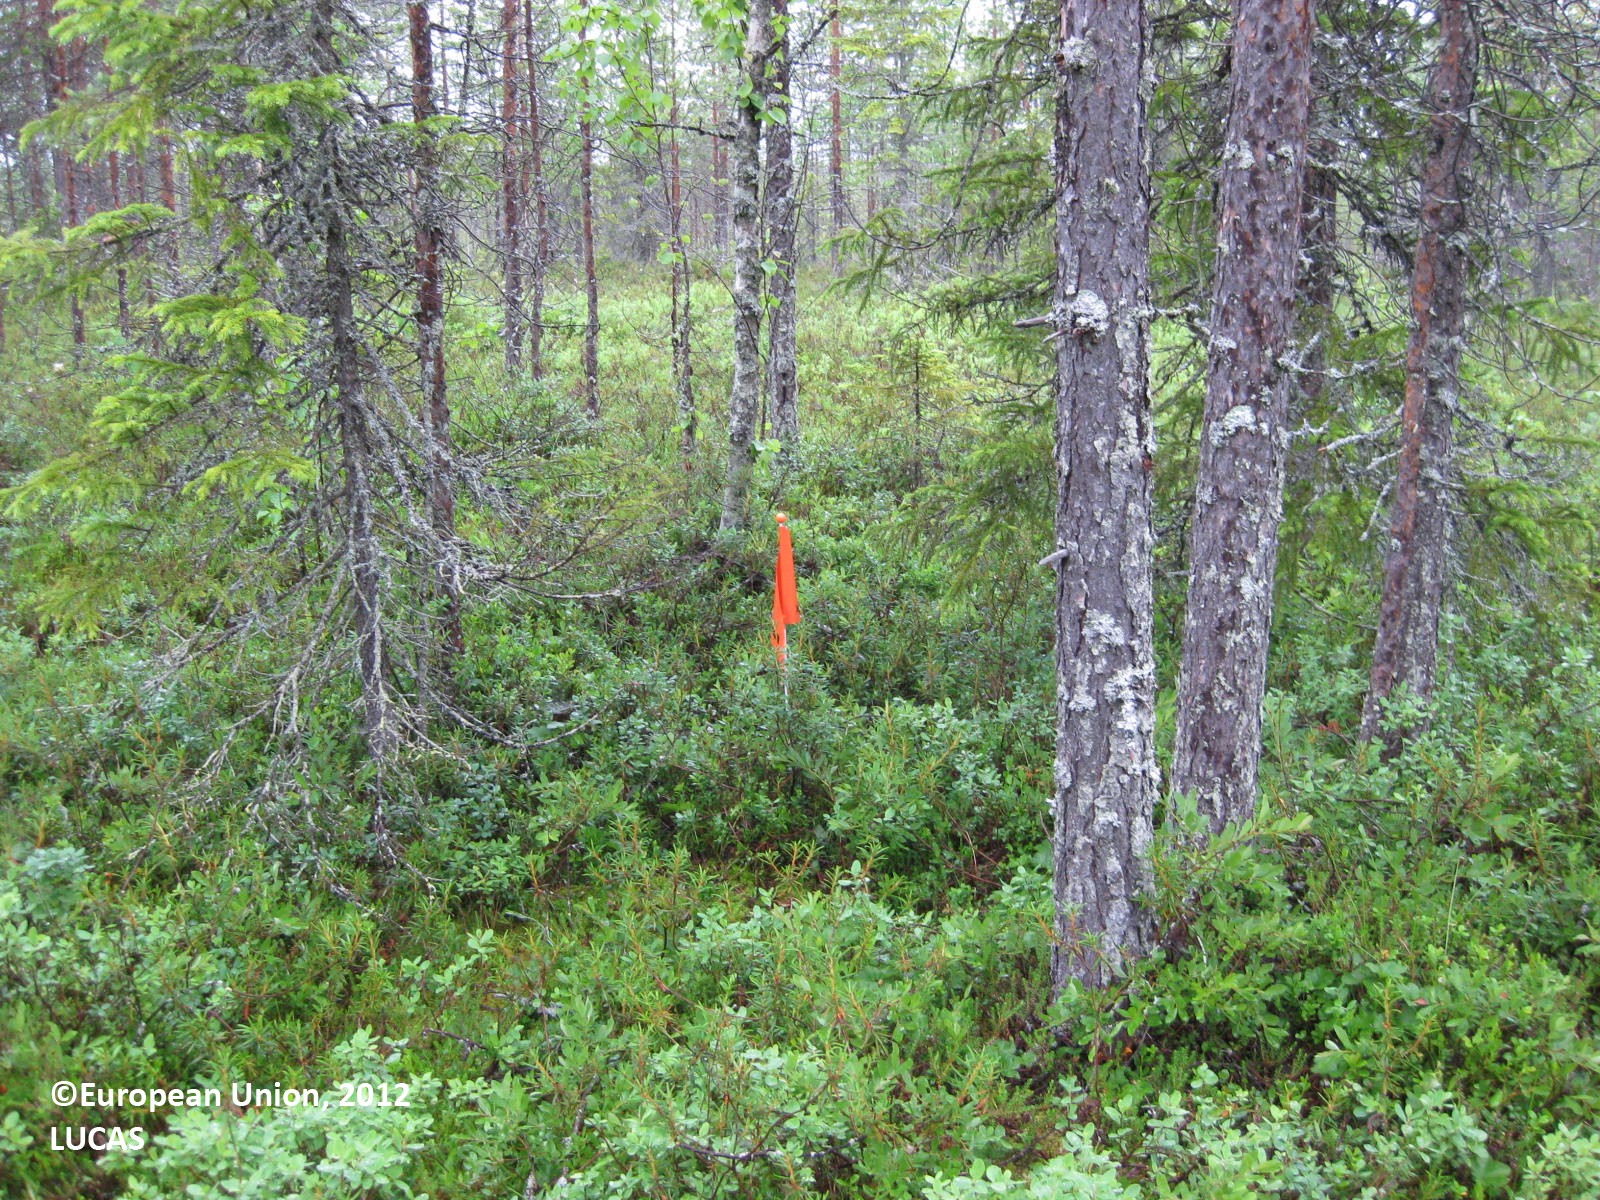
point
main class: Woodland
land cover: Pine dominated coniferous woodland
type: boreal forest
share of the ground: > 75 %
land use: Forestry
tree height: > 5 m
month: July
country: FI
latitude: 65.6216
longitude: 28.4168
